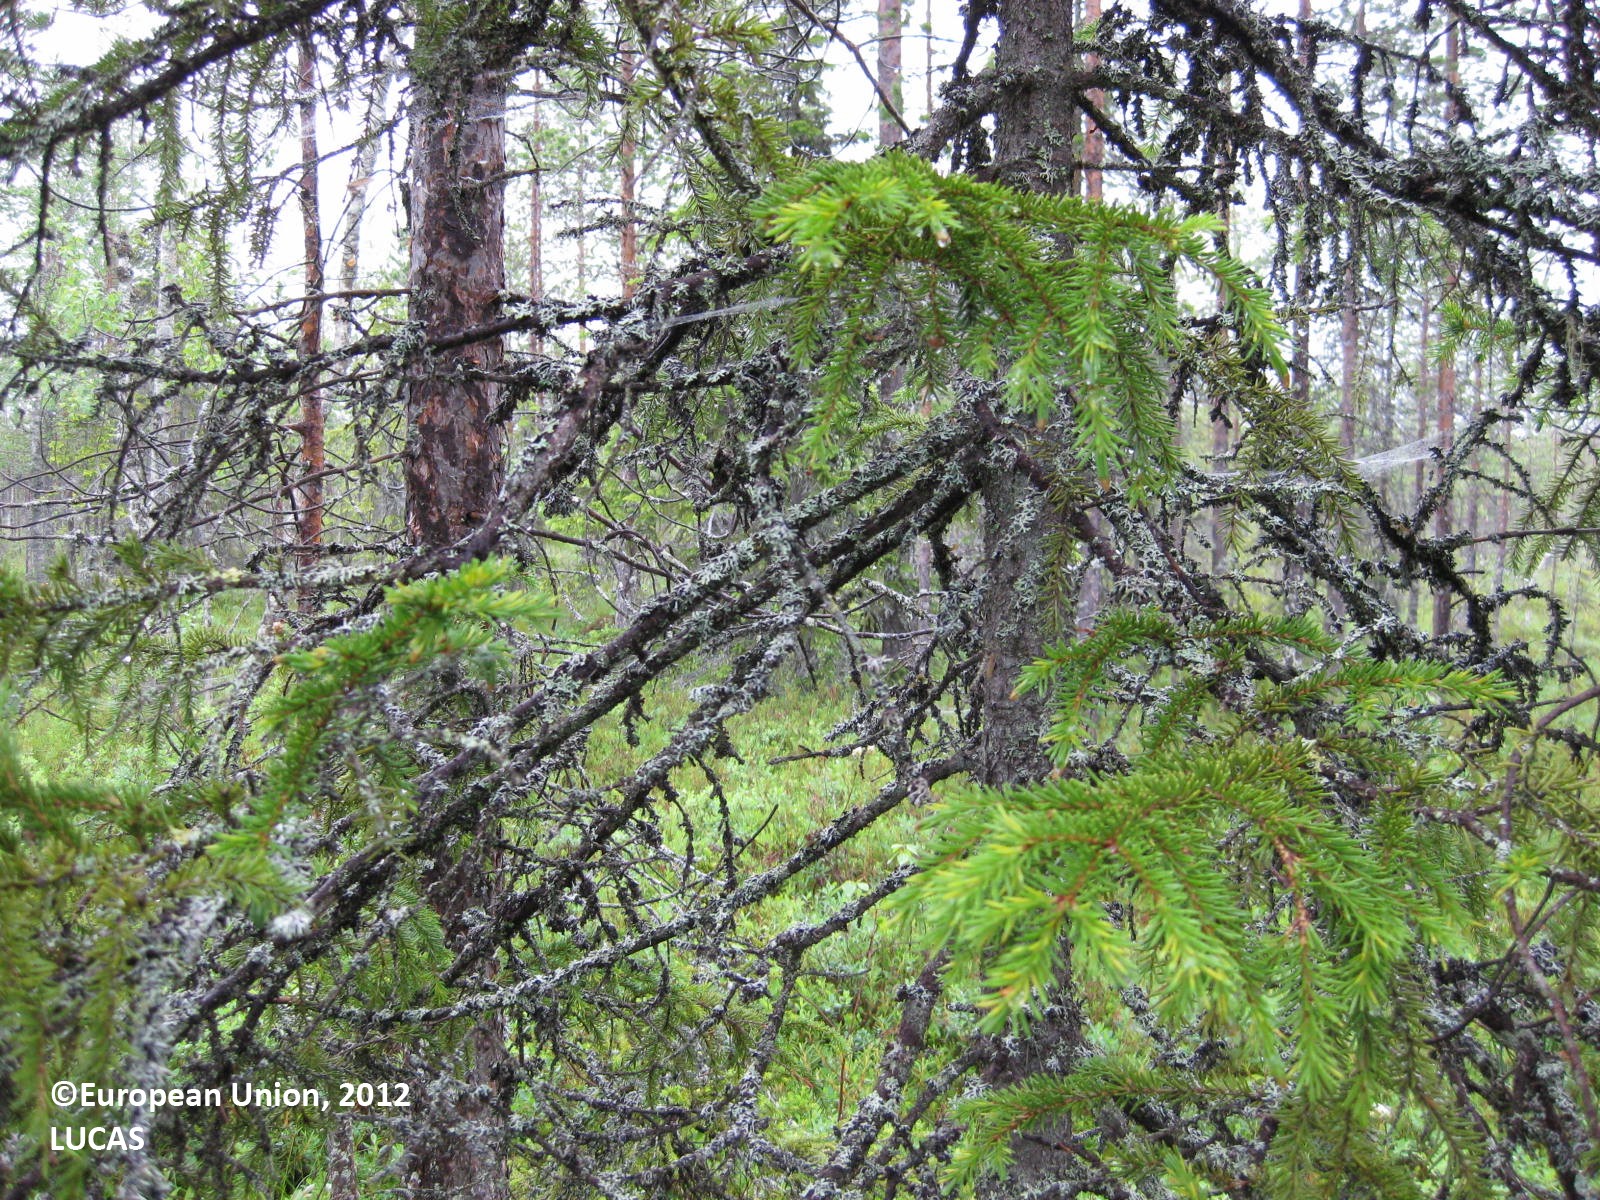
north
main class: Woodland
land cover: Pine dominated coniferous woodland
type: boreal forest
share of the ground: > 75 %
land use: Forestry
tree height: > 5 m
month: July
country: FI
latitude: 65.6216
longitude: 28.4168
